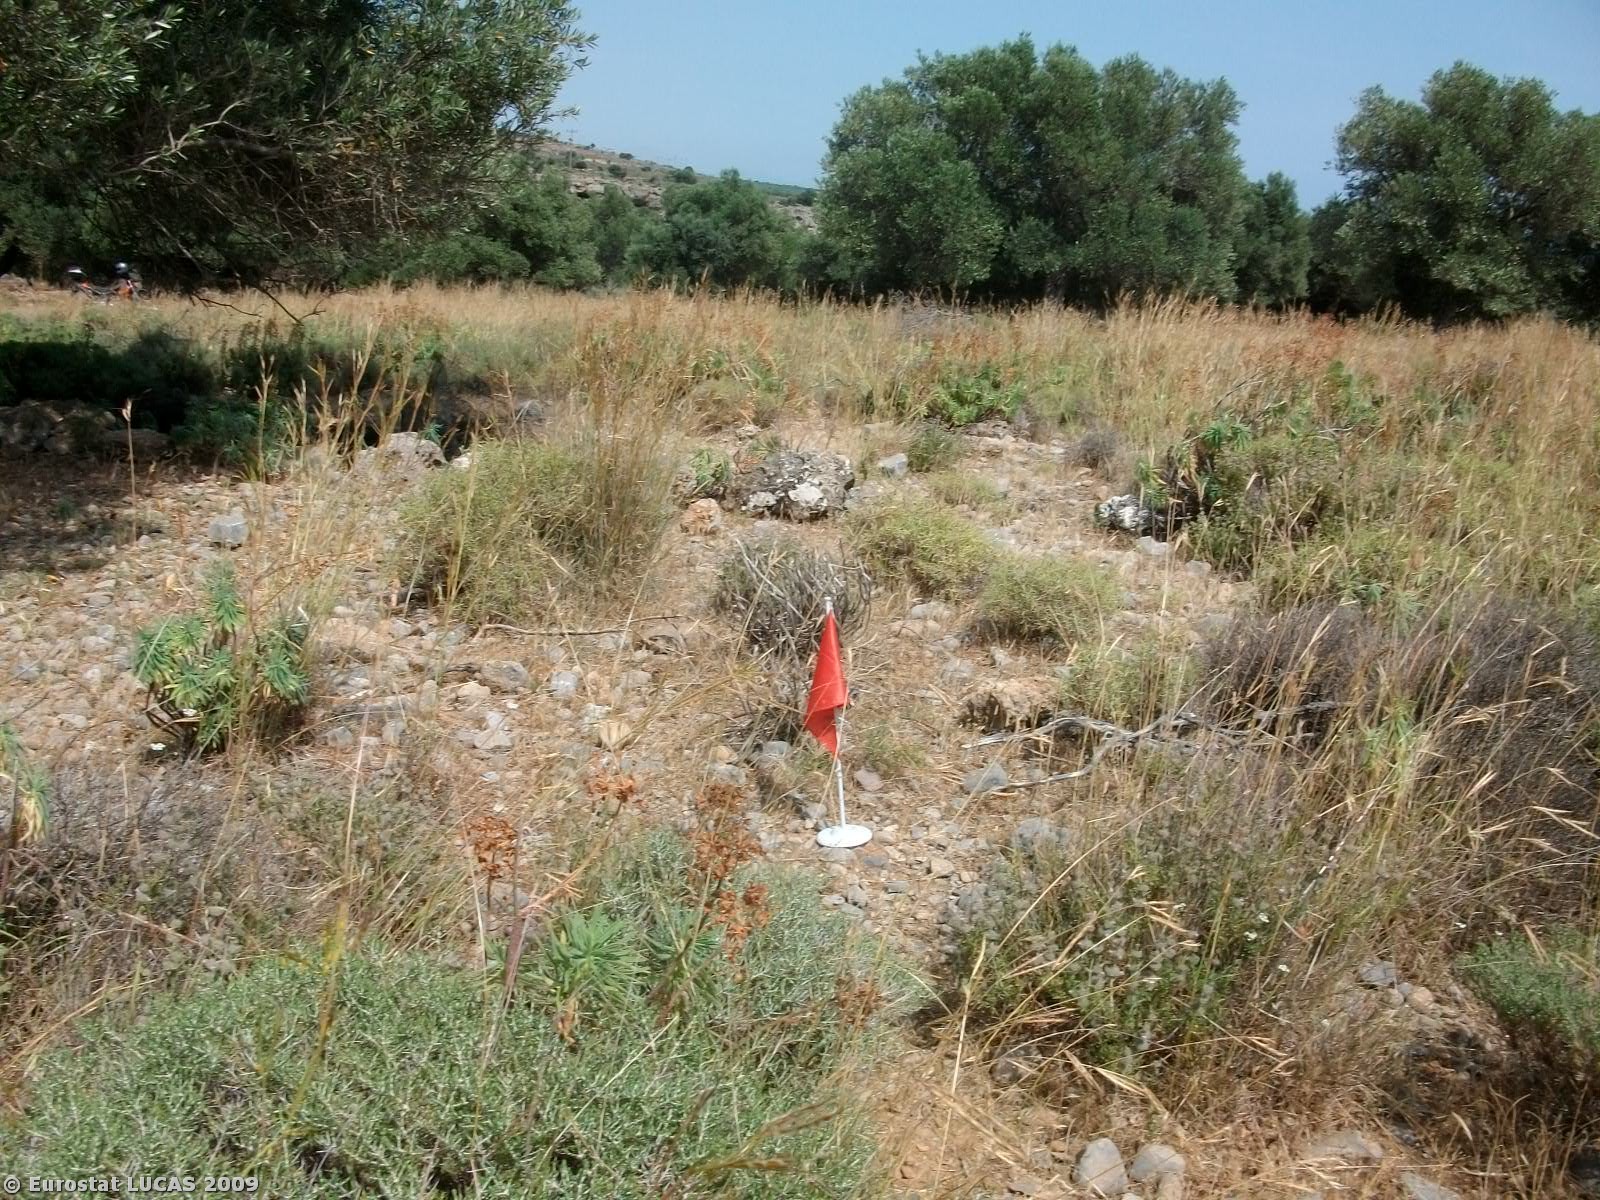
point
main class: Shrubland
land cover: Shrubland with sparse tree cover
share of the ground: > 75 %
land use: Agriculture (excluding fallow land and kitchen gardens)
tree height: < 5 m
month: June
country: GR
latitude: 35.2065
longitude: 24.1844
